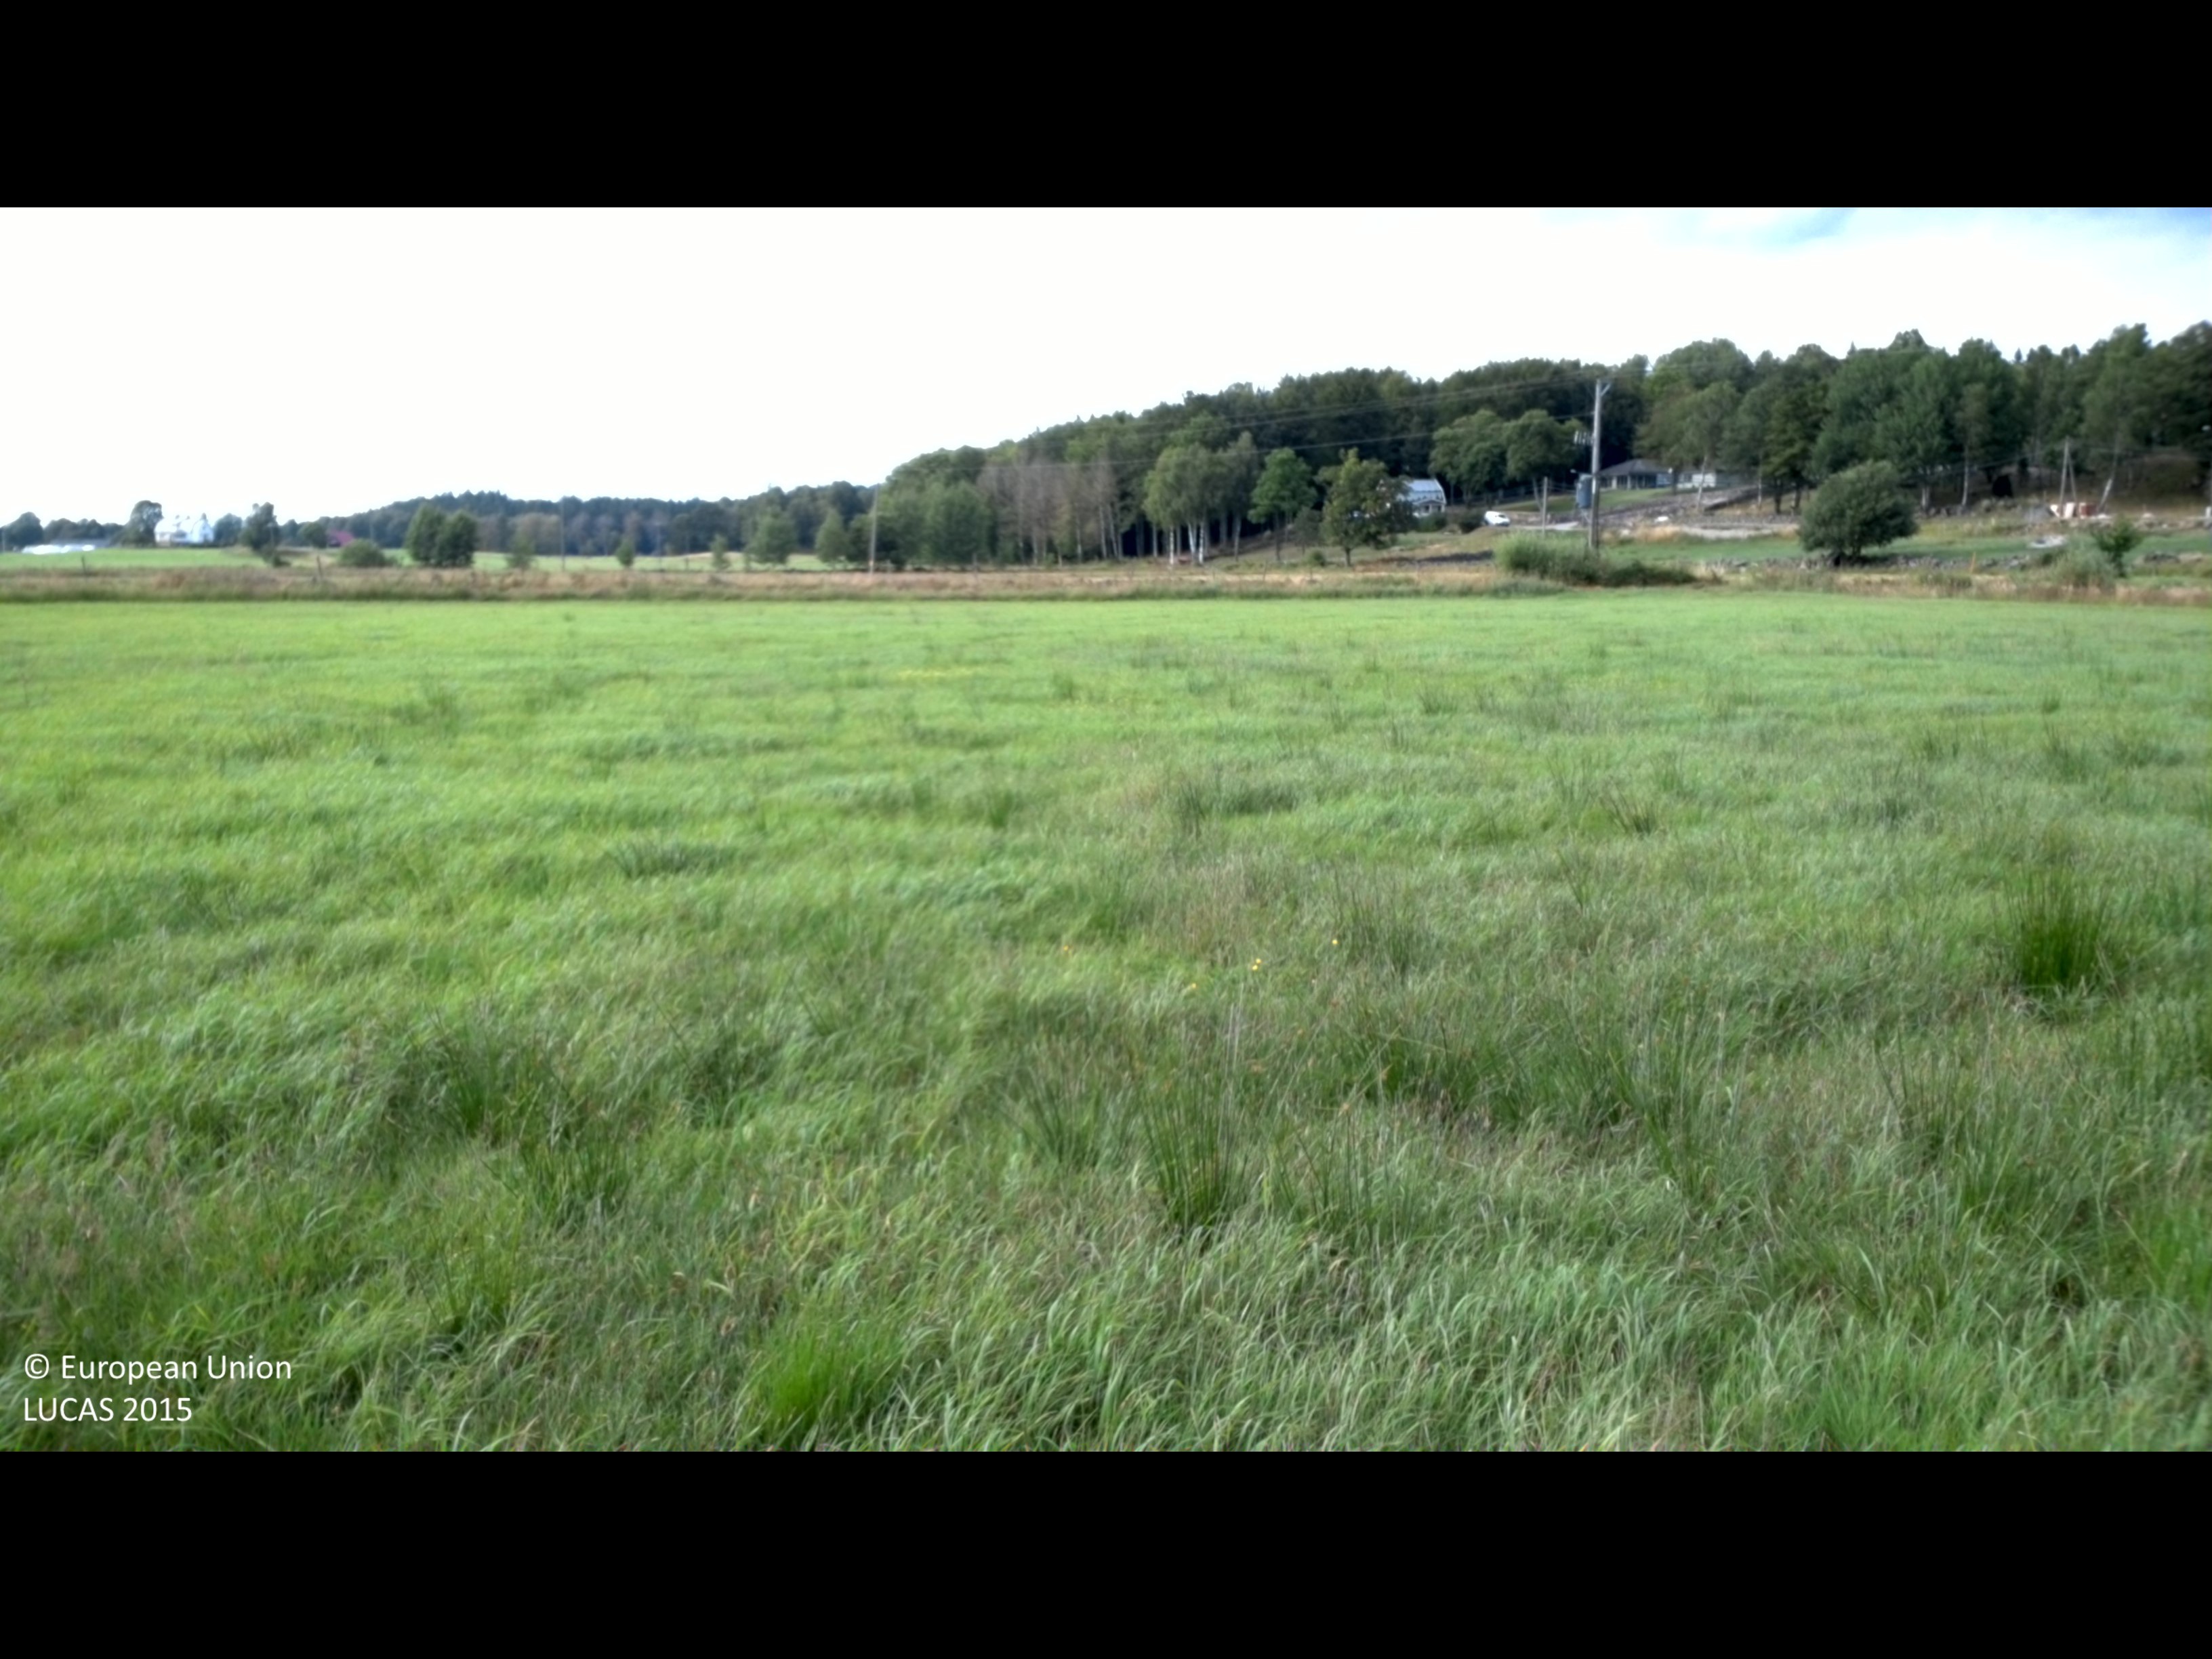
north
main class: Cropland
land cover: Temporary grasslands
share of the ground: > 75 %
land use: Agriculture (excluding fallow land and kitchen gardens)
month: July
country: SE
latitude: 56.2761
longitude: 15.3125
